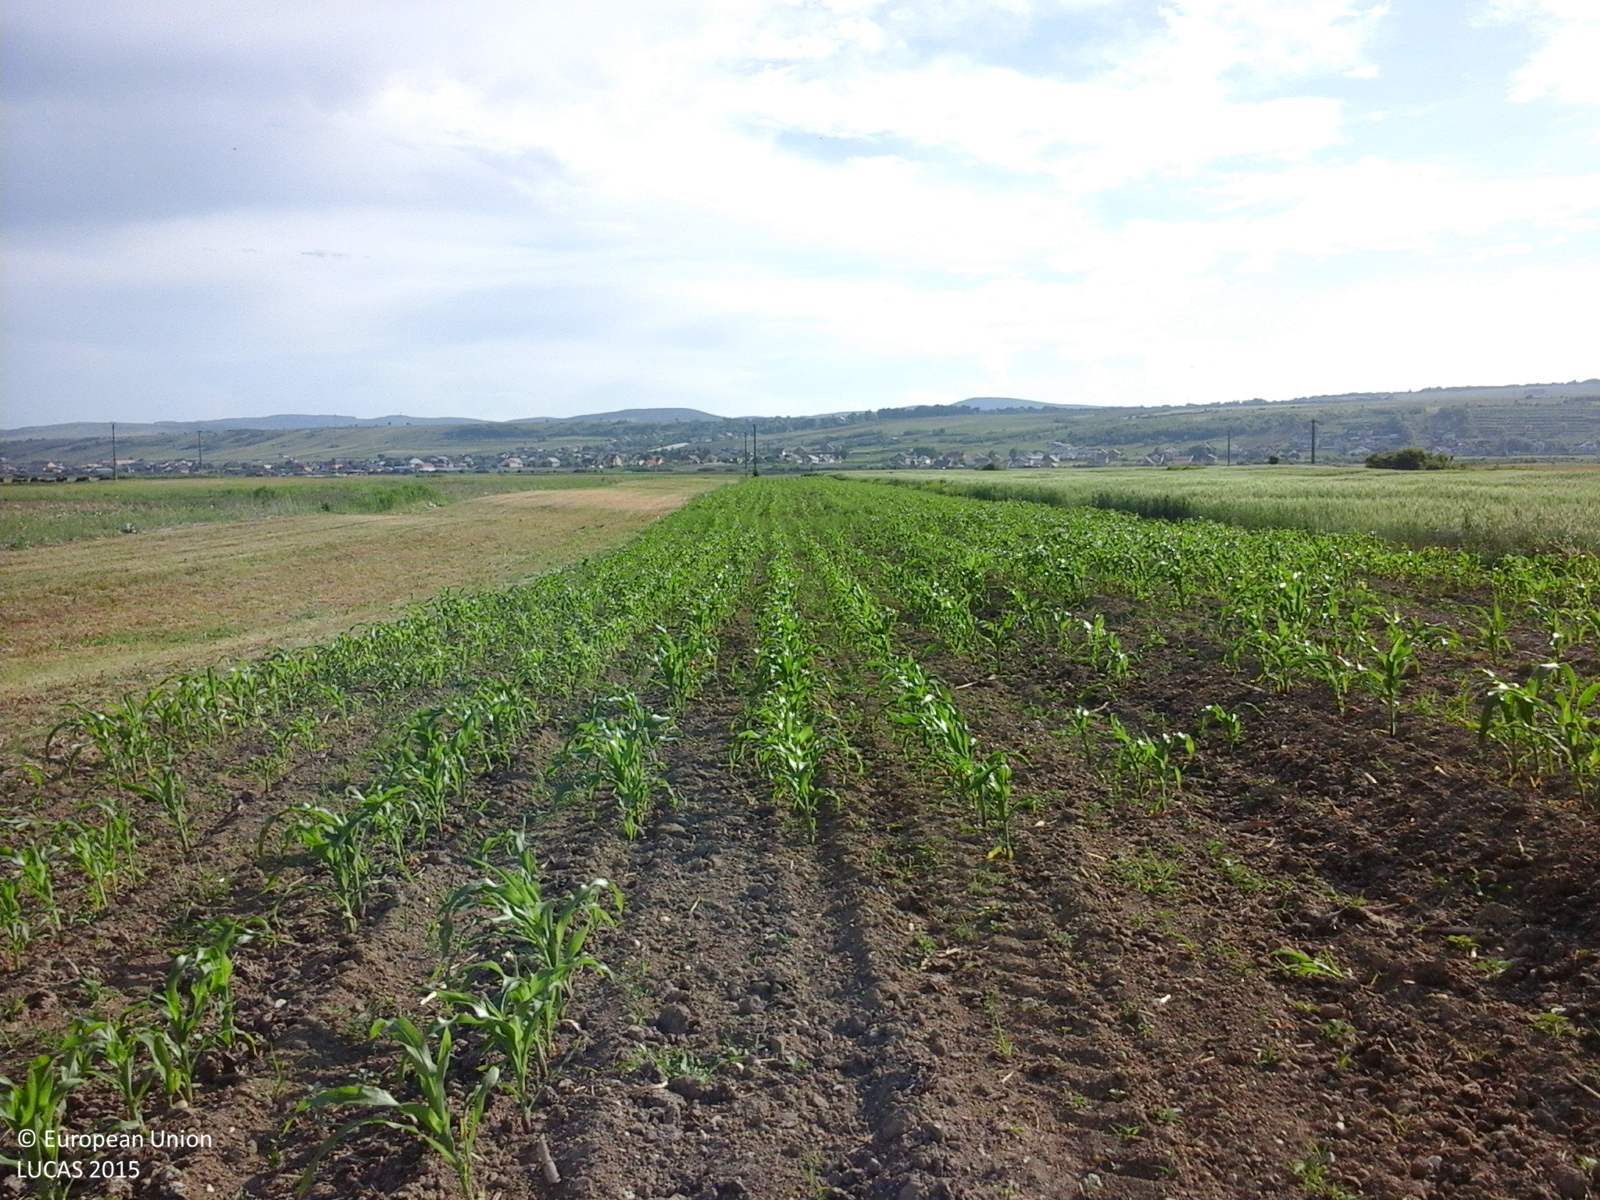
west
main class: Cropland
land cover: Maize
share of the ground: 10 - 25 %
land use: Agriculture (excluding fallow land and kitchen gardens)
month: June
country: RO
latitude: 46.6162
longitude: 26.8728
